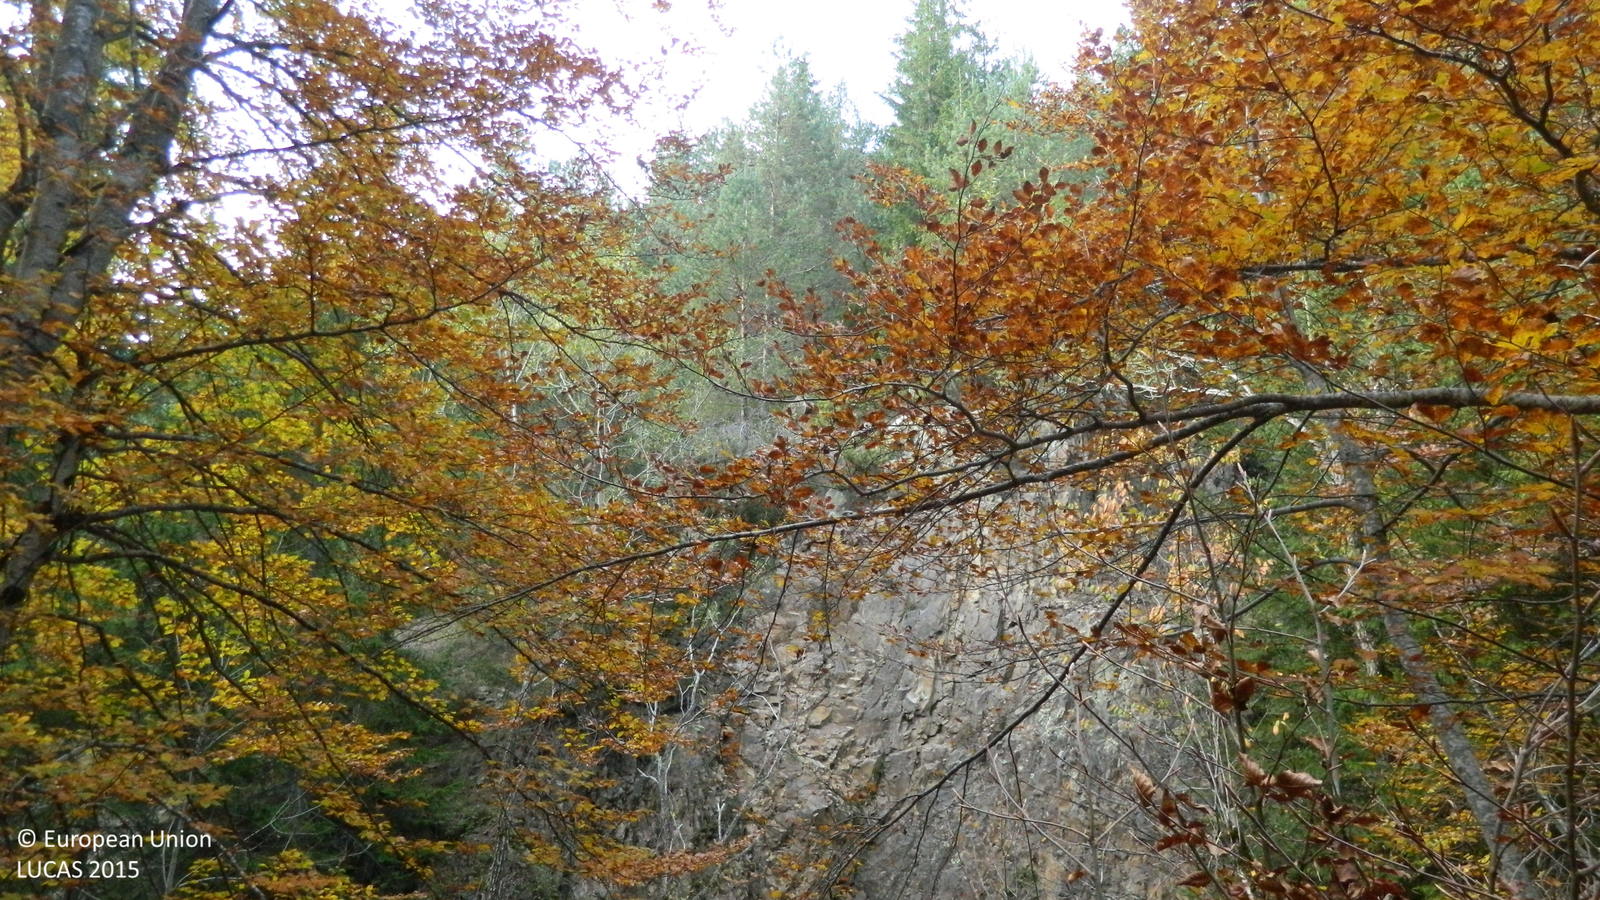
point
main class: Woodland
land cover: Pine dominated coniferous woodland
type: alpine coniferous forest
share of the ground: > 75 %
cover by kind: coniferous forest trees 90 %, unconsolidated bare surface 10 %
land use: Forestry
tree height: > 5 m
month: October
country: BG
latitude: 41.5340
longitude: 24.6042
